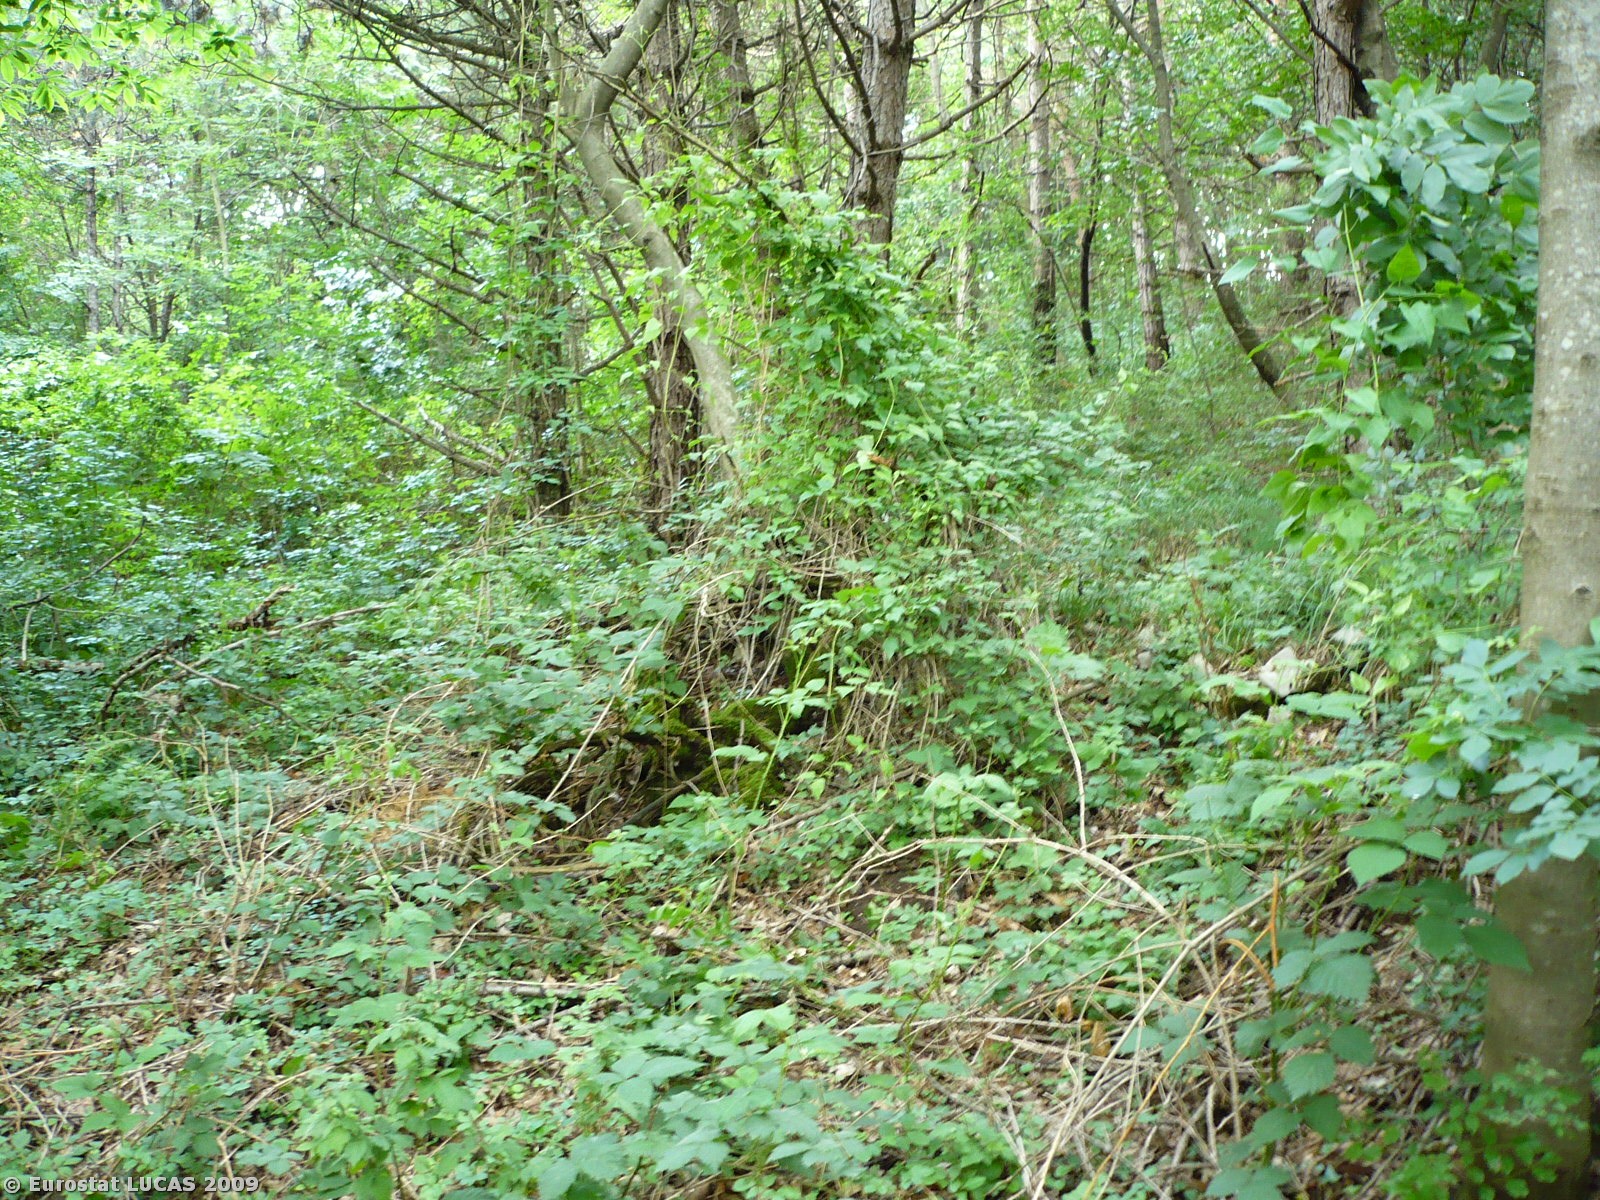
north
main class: Woodland
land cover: Broadleaved woodland
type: thermophilous deciduous forest
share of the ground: > 75 %
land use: Unused
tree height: > 5 m
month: June
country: SI
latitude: 46.0364
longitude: 13.6529
